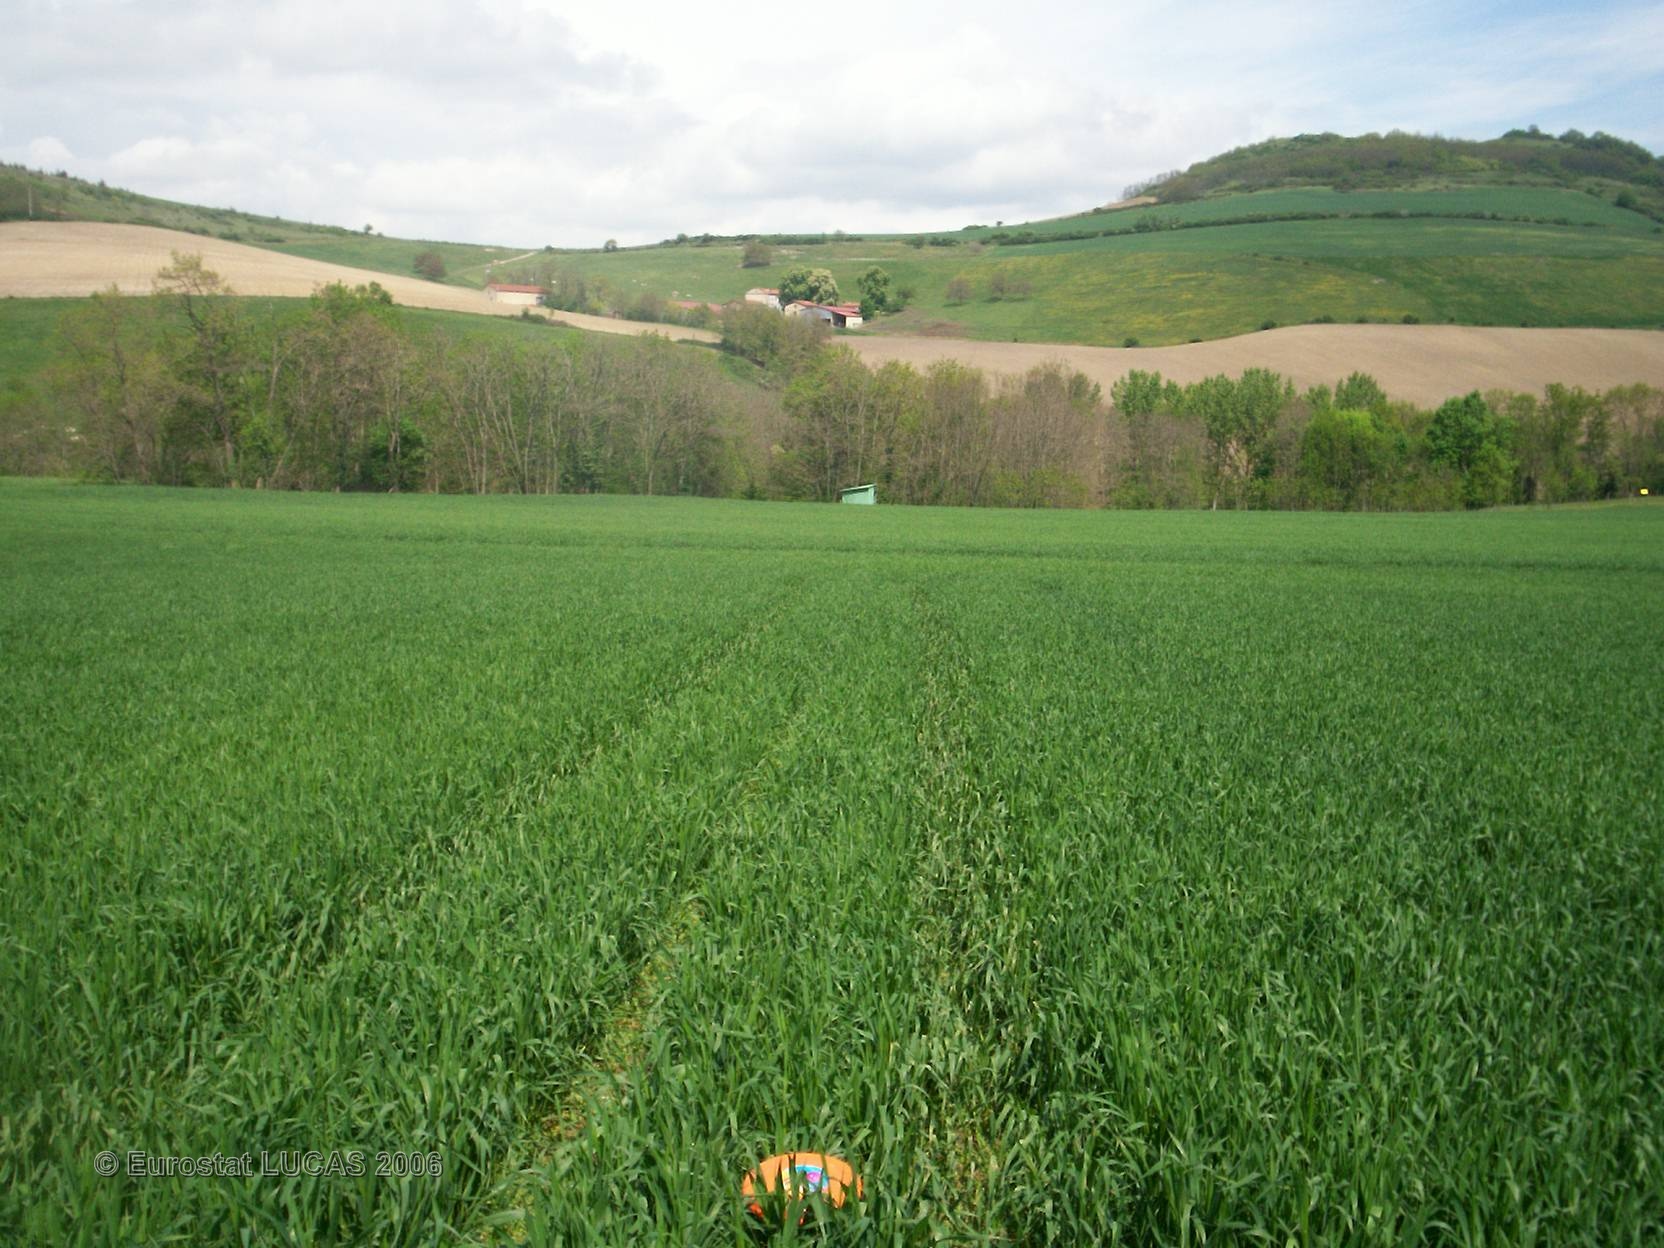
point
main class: Cropland
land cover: Common wheat
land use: Agriculture (excluding fallow land and kitchen gardens)
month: May
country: FR
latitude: 45.5757
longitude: 3.2217
